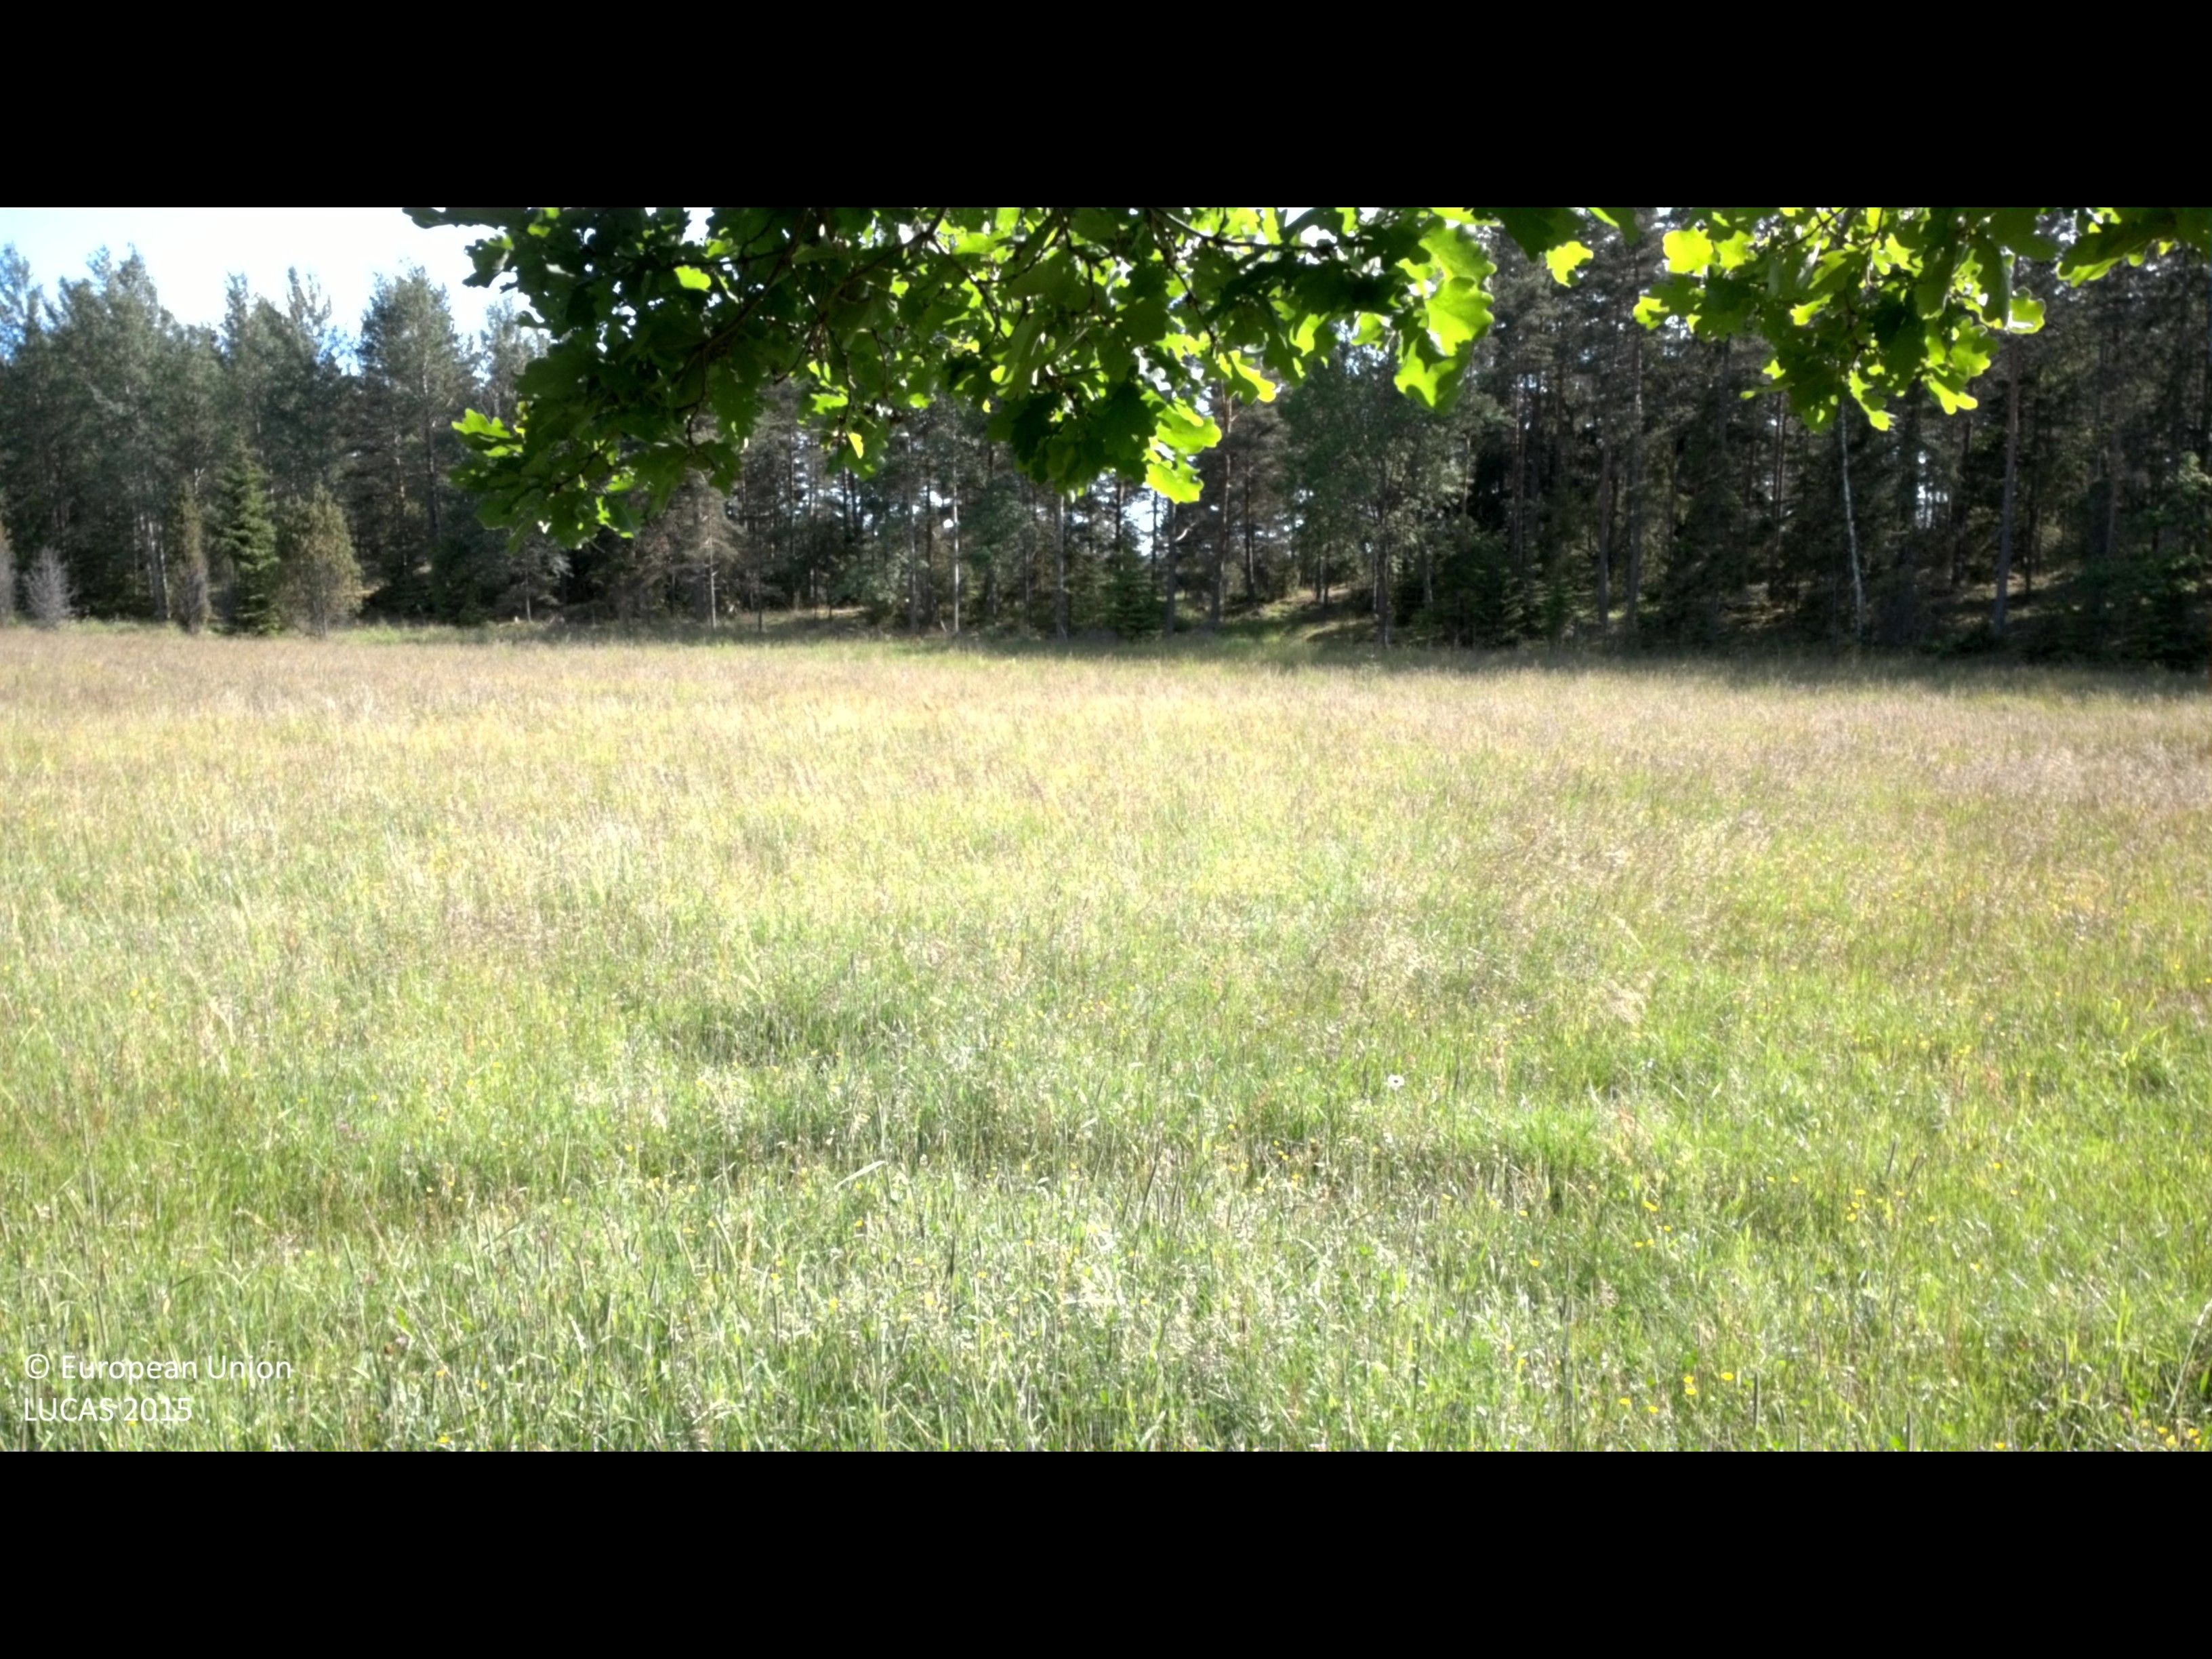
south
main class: Woodland
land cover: Spruce dominated mixed woodland
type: boreal forest
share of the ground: > 75 %
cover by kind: coniferous forest trees 65 %, broadleaved forest trees 25 %, herbaceous plants 5 %, unconsolidated bare surface 5 %
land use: Forestry
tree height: > 5 m
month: June
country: SE
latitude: 58.0366
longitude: 16.6541
